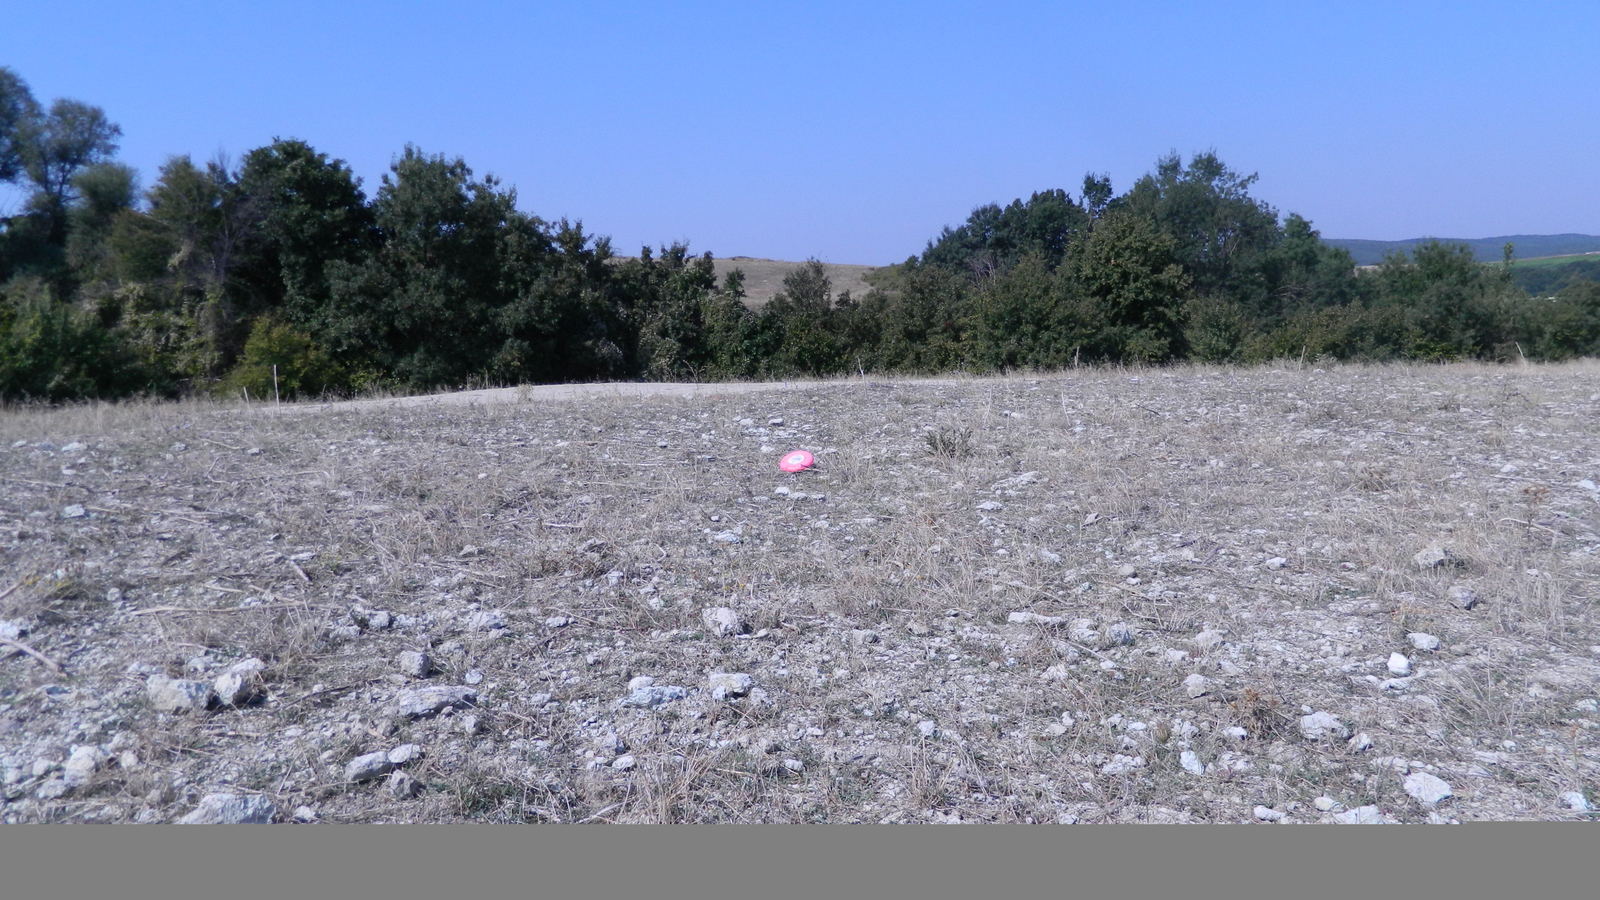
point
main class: Grassland
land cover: Spontaneously vegetated surfaces
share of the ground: 50 - 75 %
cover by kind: herbaceous plants 70 %, unconsolidated bare surface 30 %
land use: Agriculture (excluding fallow land and kitchen gardens)
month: September
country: BG
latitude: 41.7144
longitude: 25.7014
